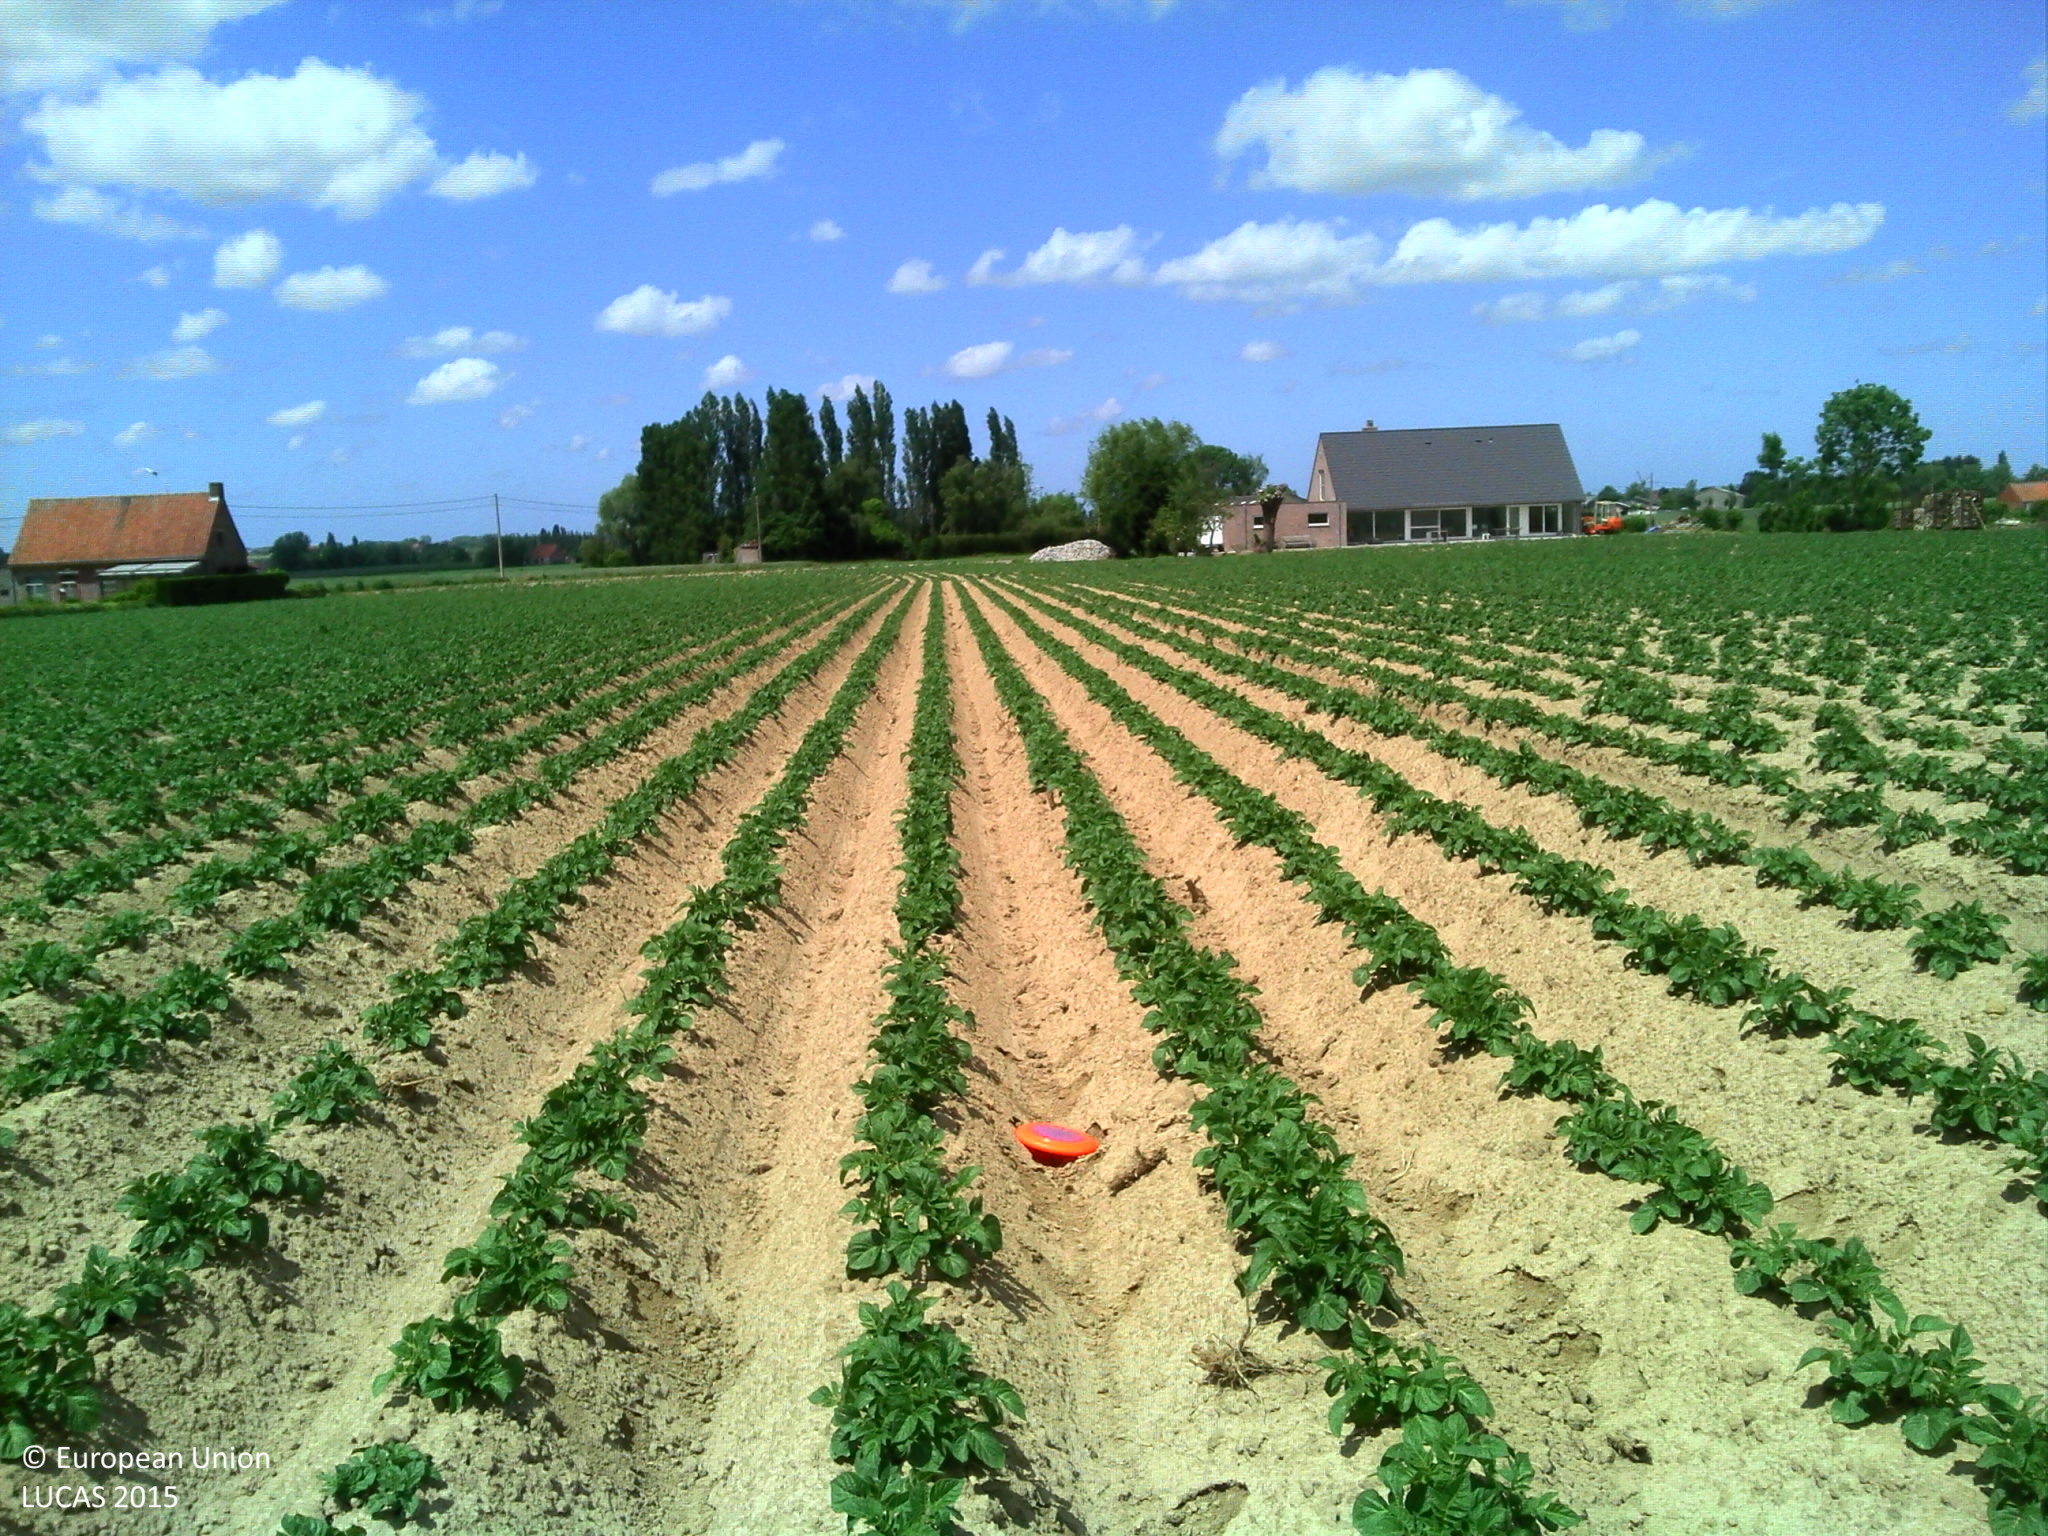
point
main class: Cropland
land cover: Potatoes
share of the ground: 10 - 25 %
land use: Agriculture (excluding fallow land and kitchen gardens)
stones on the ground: < 10 %
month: June
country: BE
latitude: 50.8369
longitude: 2.7324
